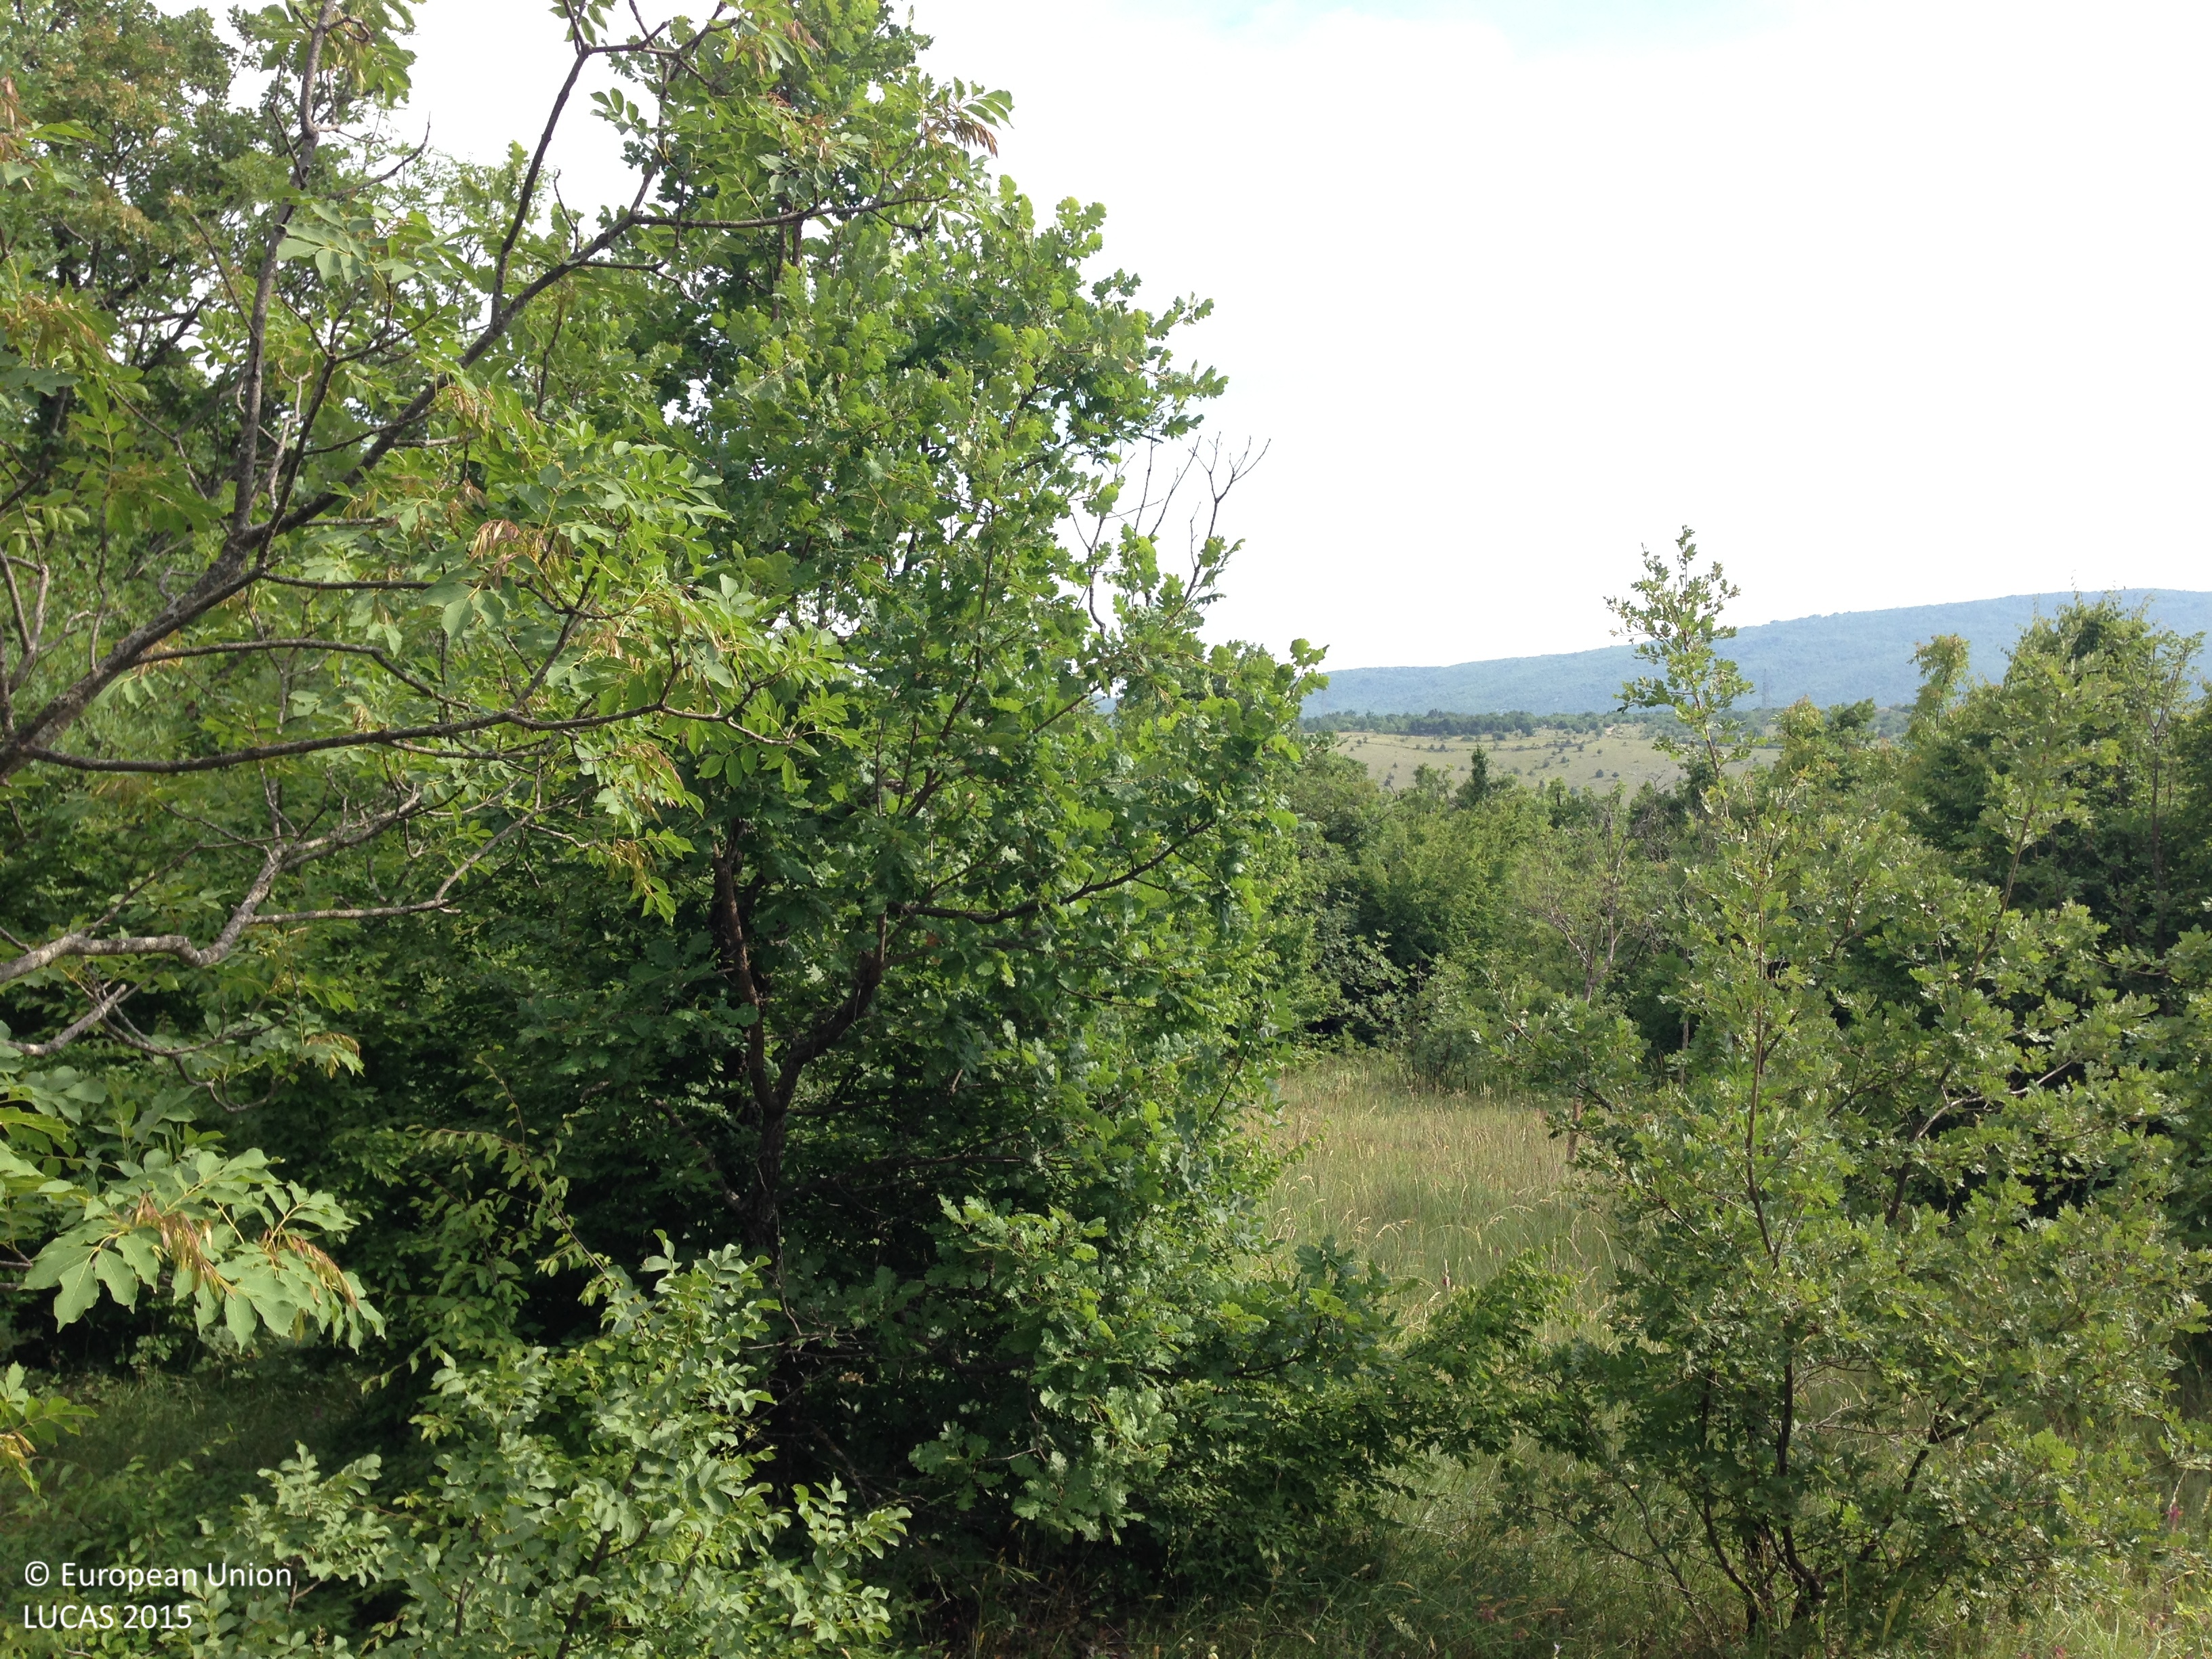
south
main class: Woodland
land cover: Broadleaved woodland
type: thermophilous deciduous forest
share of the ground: 25 - 50 %
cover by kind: herbaceous plants 40 %, broadleaved forest trees 35 %, shrubs 10 %, unconsolidated bare surface 10 %, consolidated bare surface 5 %
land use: Semi-natural and natural areas not in use
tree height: > 5 m
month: June
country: HR
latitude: 43.7377
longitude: 16.3860
